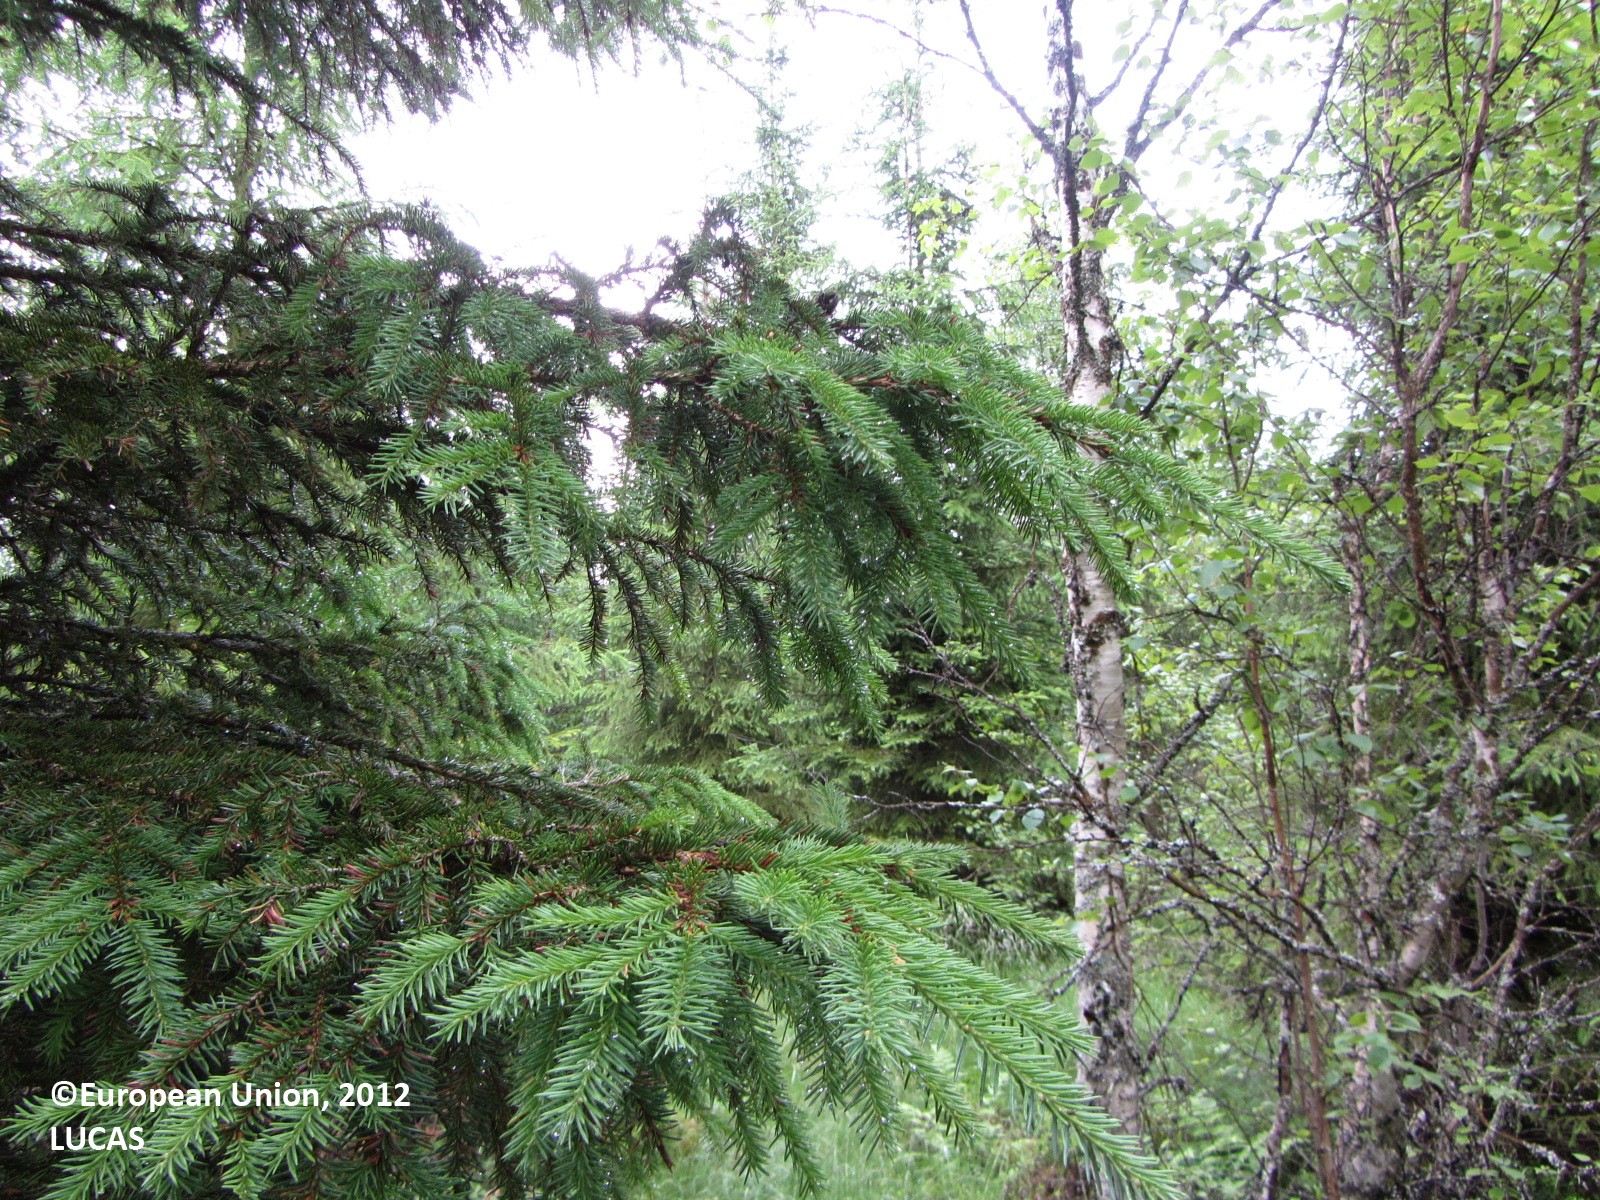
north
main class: Woodland
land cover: Spruce dominated mixed woodland
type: boreal forest
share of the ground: 50 - 75 %
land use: Forestry
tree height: > 5 m
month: July
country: FI
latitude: 63.8442
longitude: 25.5725
